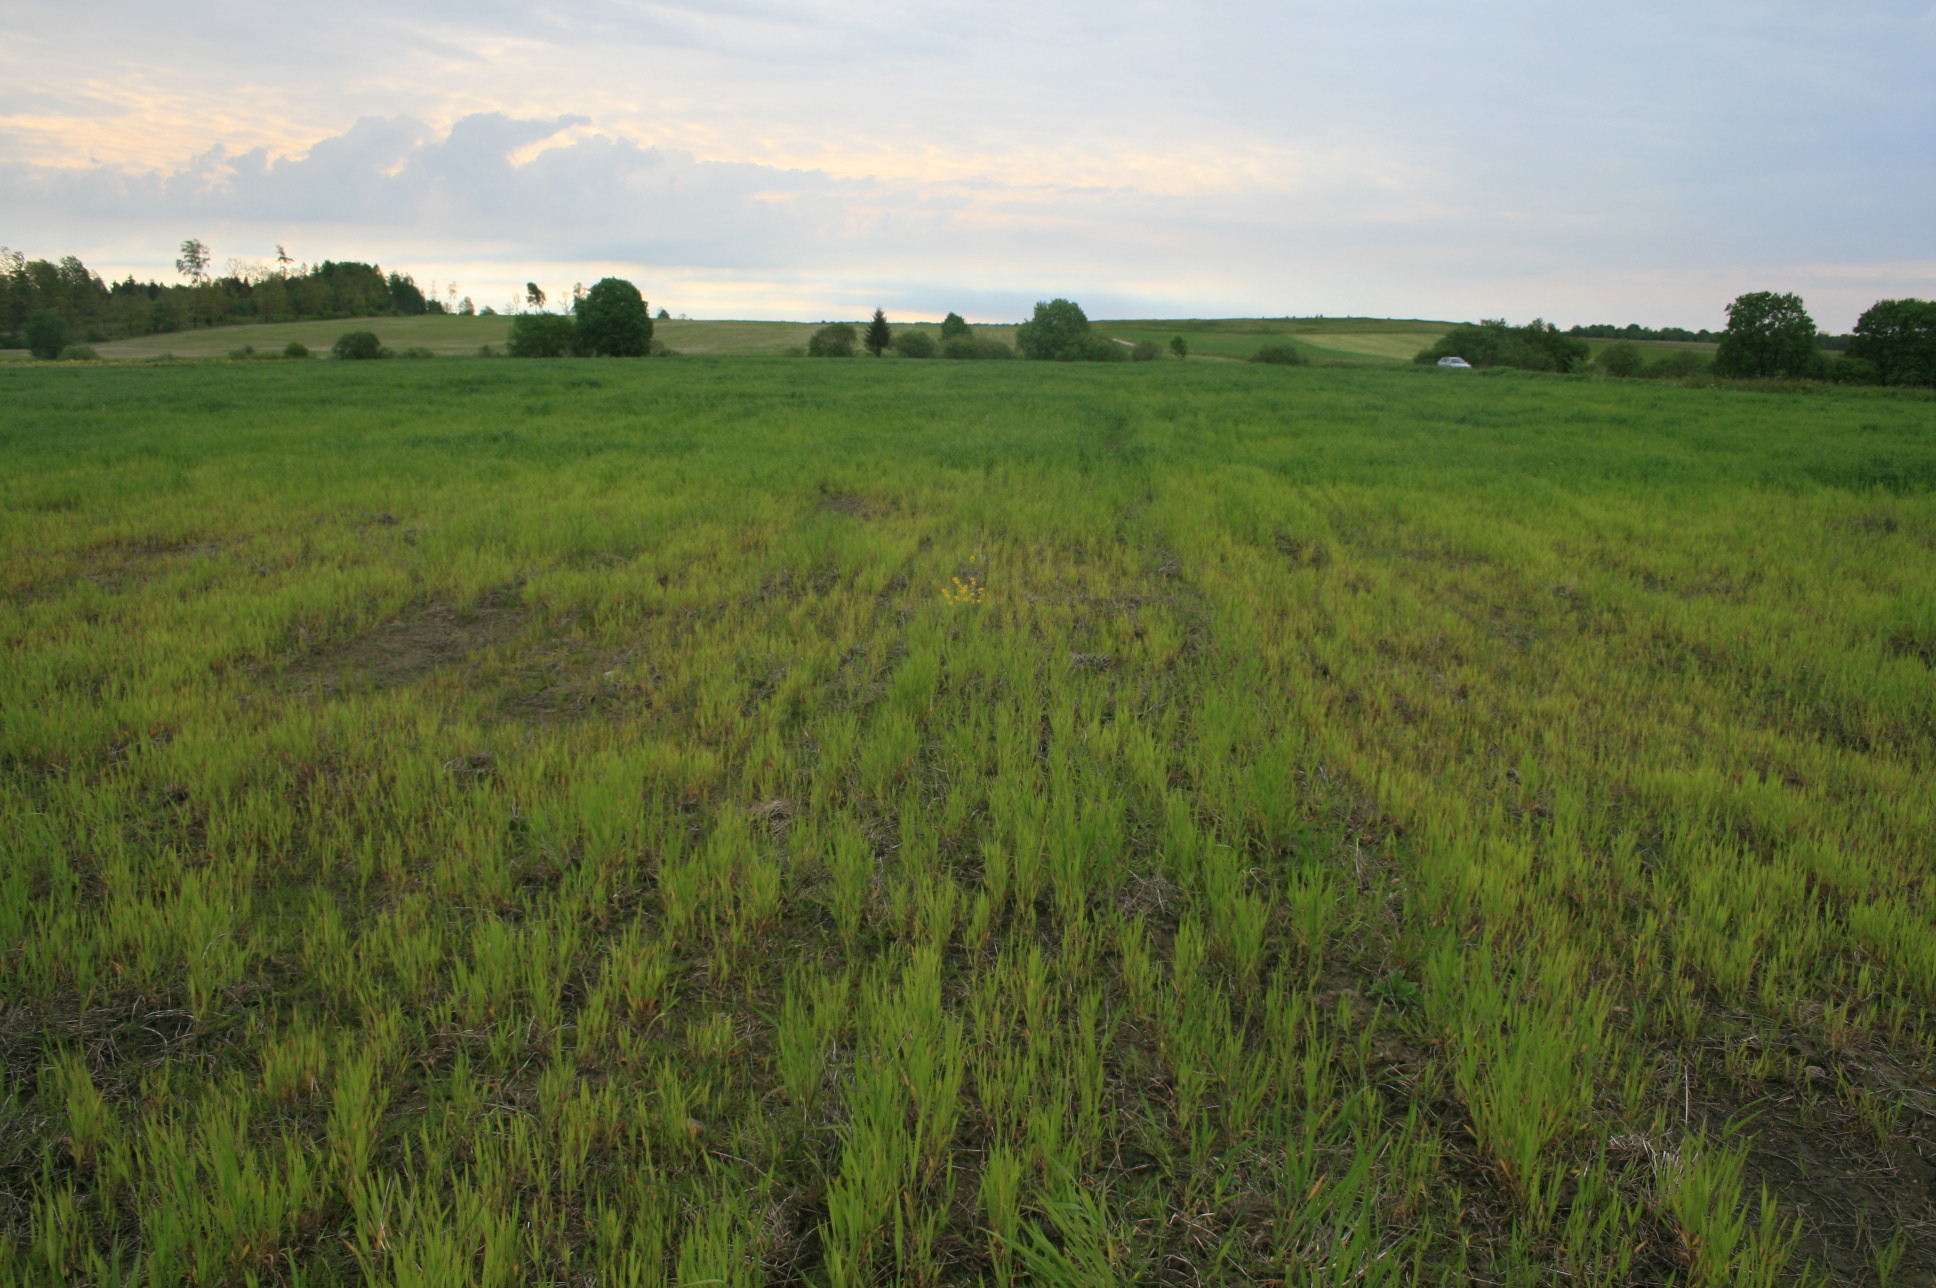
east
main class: Cropland
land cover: Common wheat
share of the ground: > 75 %
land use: Agriculture (excluding fallow land and kitchen gardens)
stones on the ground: < 10 %
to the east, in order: Common wheat; Broadleaved woodland; Ditches and canals; Abandoned hedges; Grassland without tree/shrub cover
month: May
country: LT
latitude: 55.8364
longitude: 21.6551
